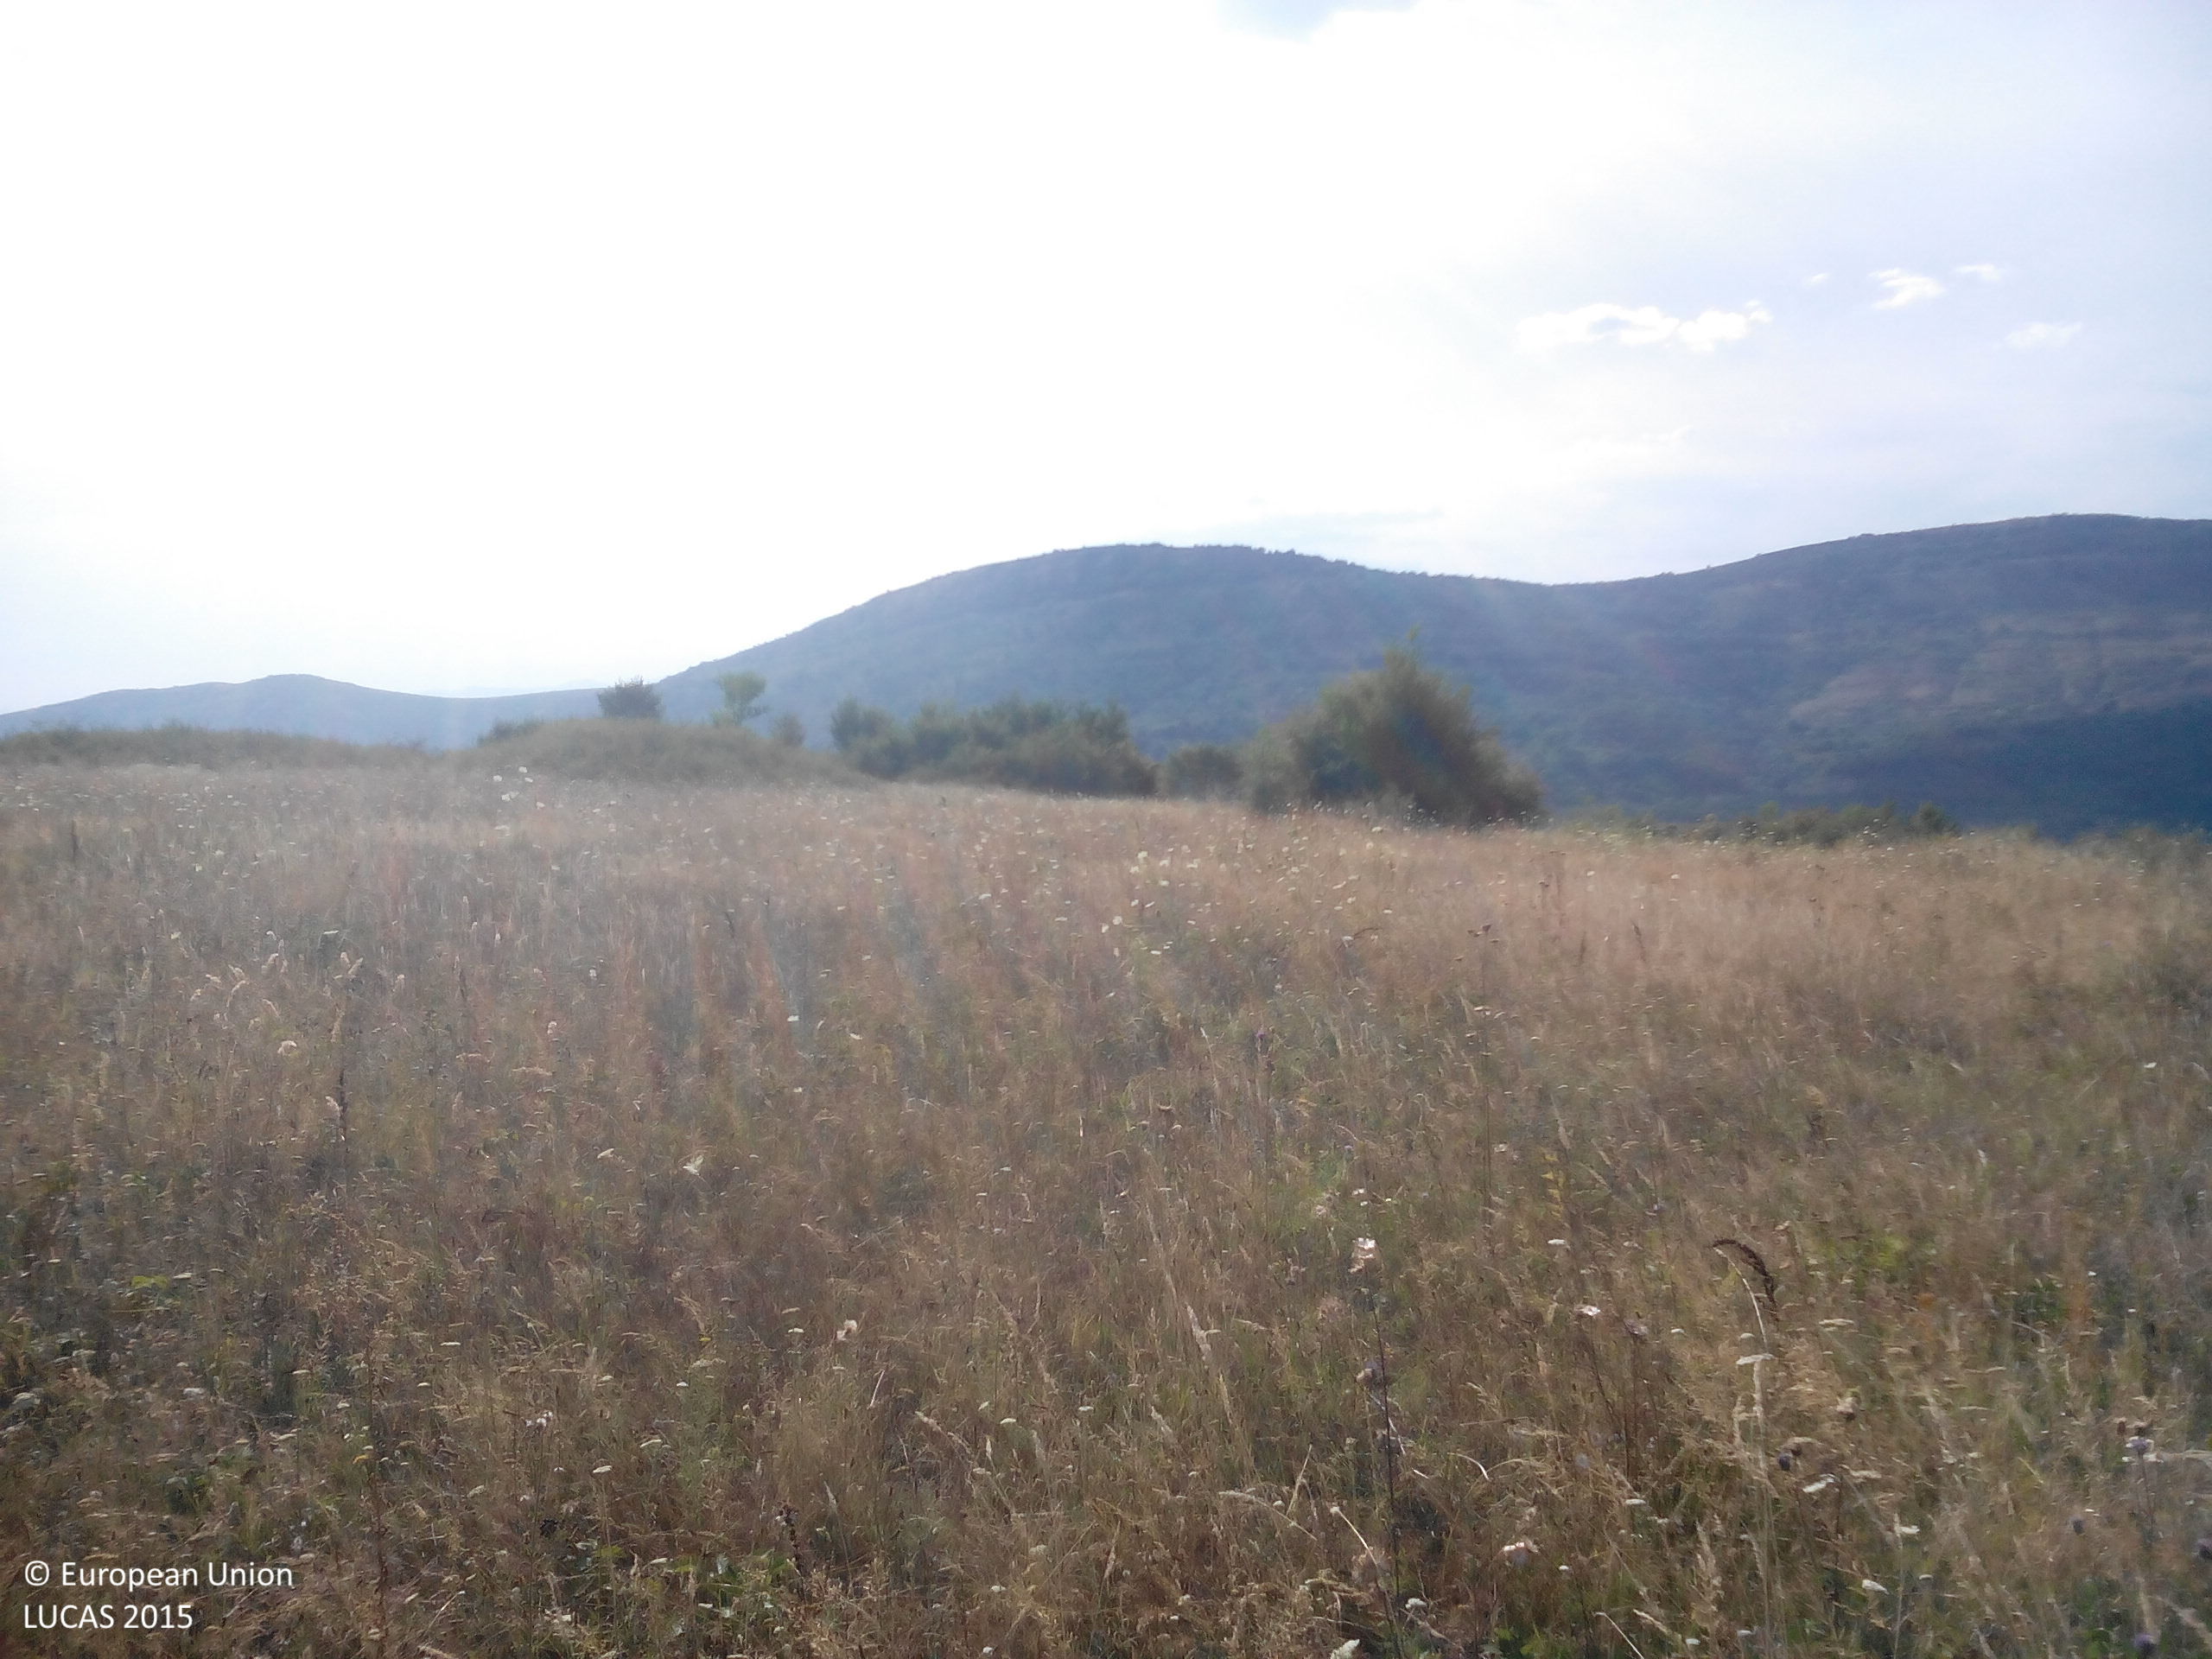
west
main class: Grassland
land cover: Grassland without tree/shrub cover
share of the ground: > 75 %
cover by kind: herbaceous plants 100 %
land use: Agriculture (excluding fallow land and kitchen gardens)
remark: Harvested field
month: August
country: BG
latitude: 43.1529
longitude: 23.9068
